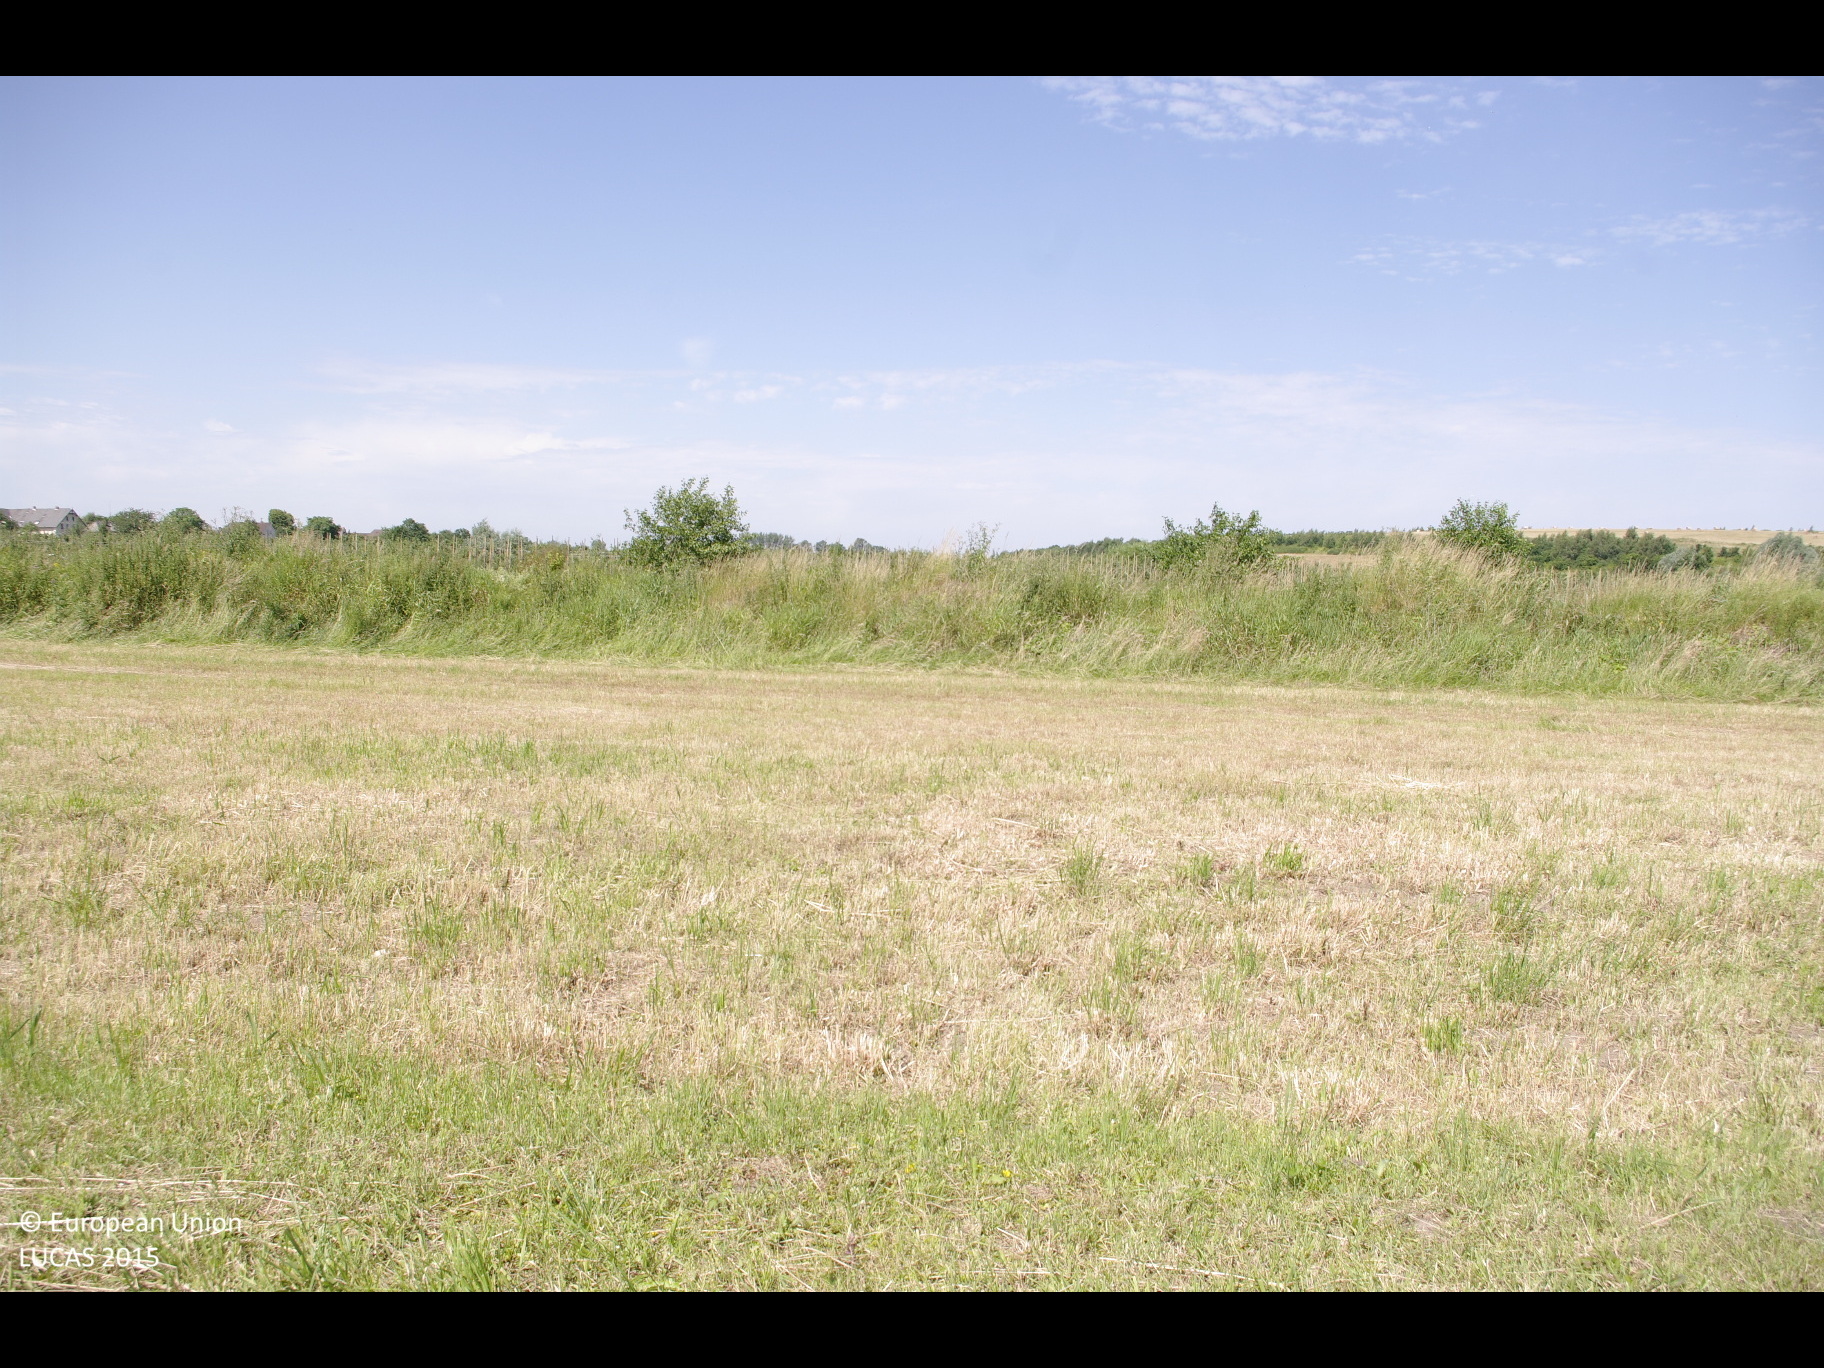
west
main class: Grassland
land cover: Grassland without tree/shrub cover
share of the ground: > 75 %
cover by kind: herbaceous plants 100 %
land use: Agriculture (excluding fallow land and kitchen gardens)
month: July
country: DE
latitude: 53.5097
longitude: 9.8644
